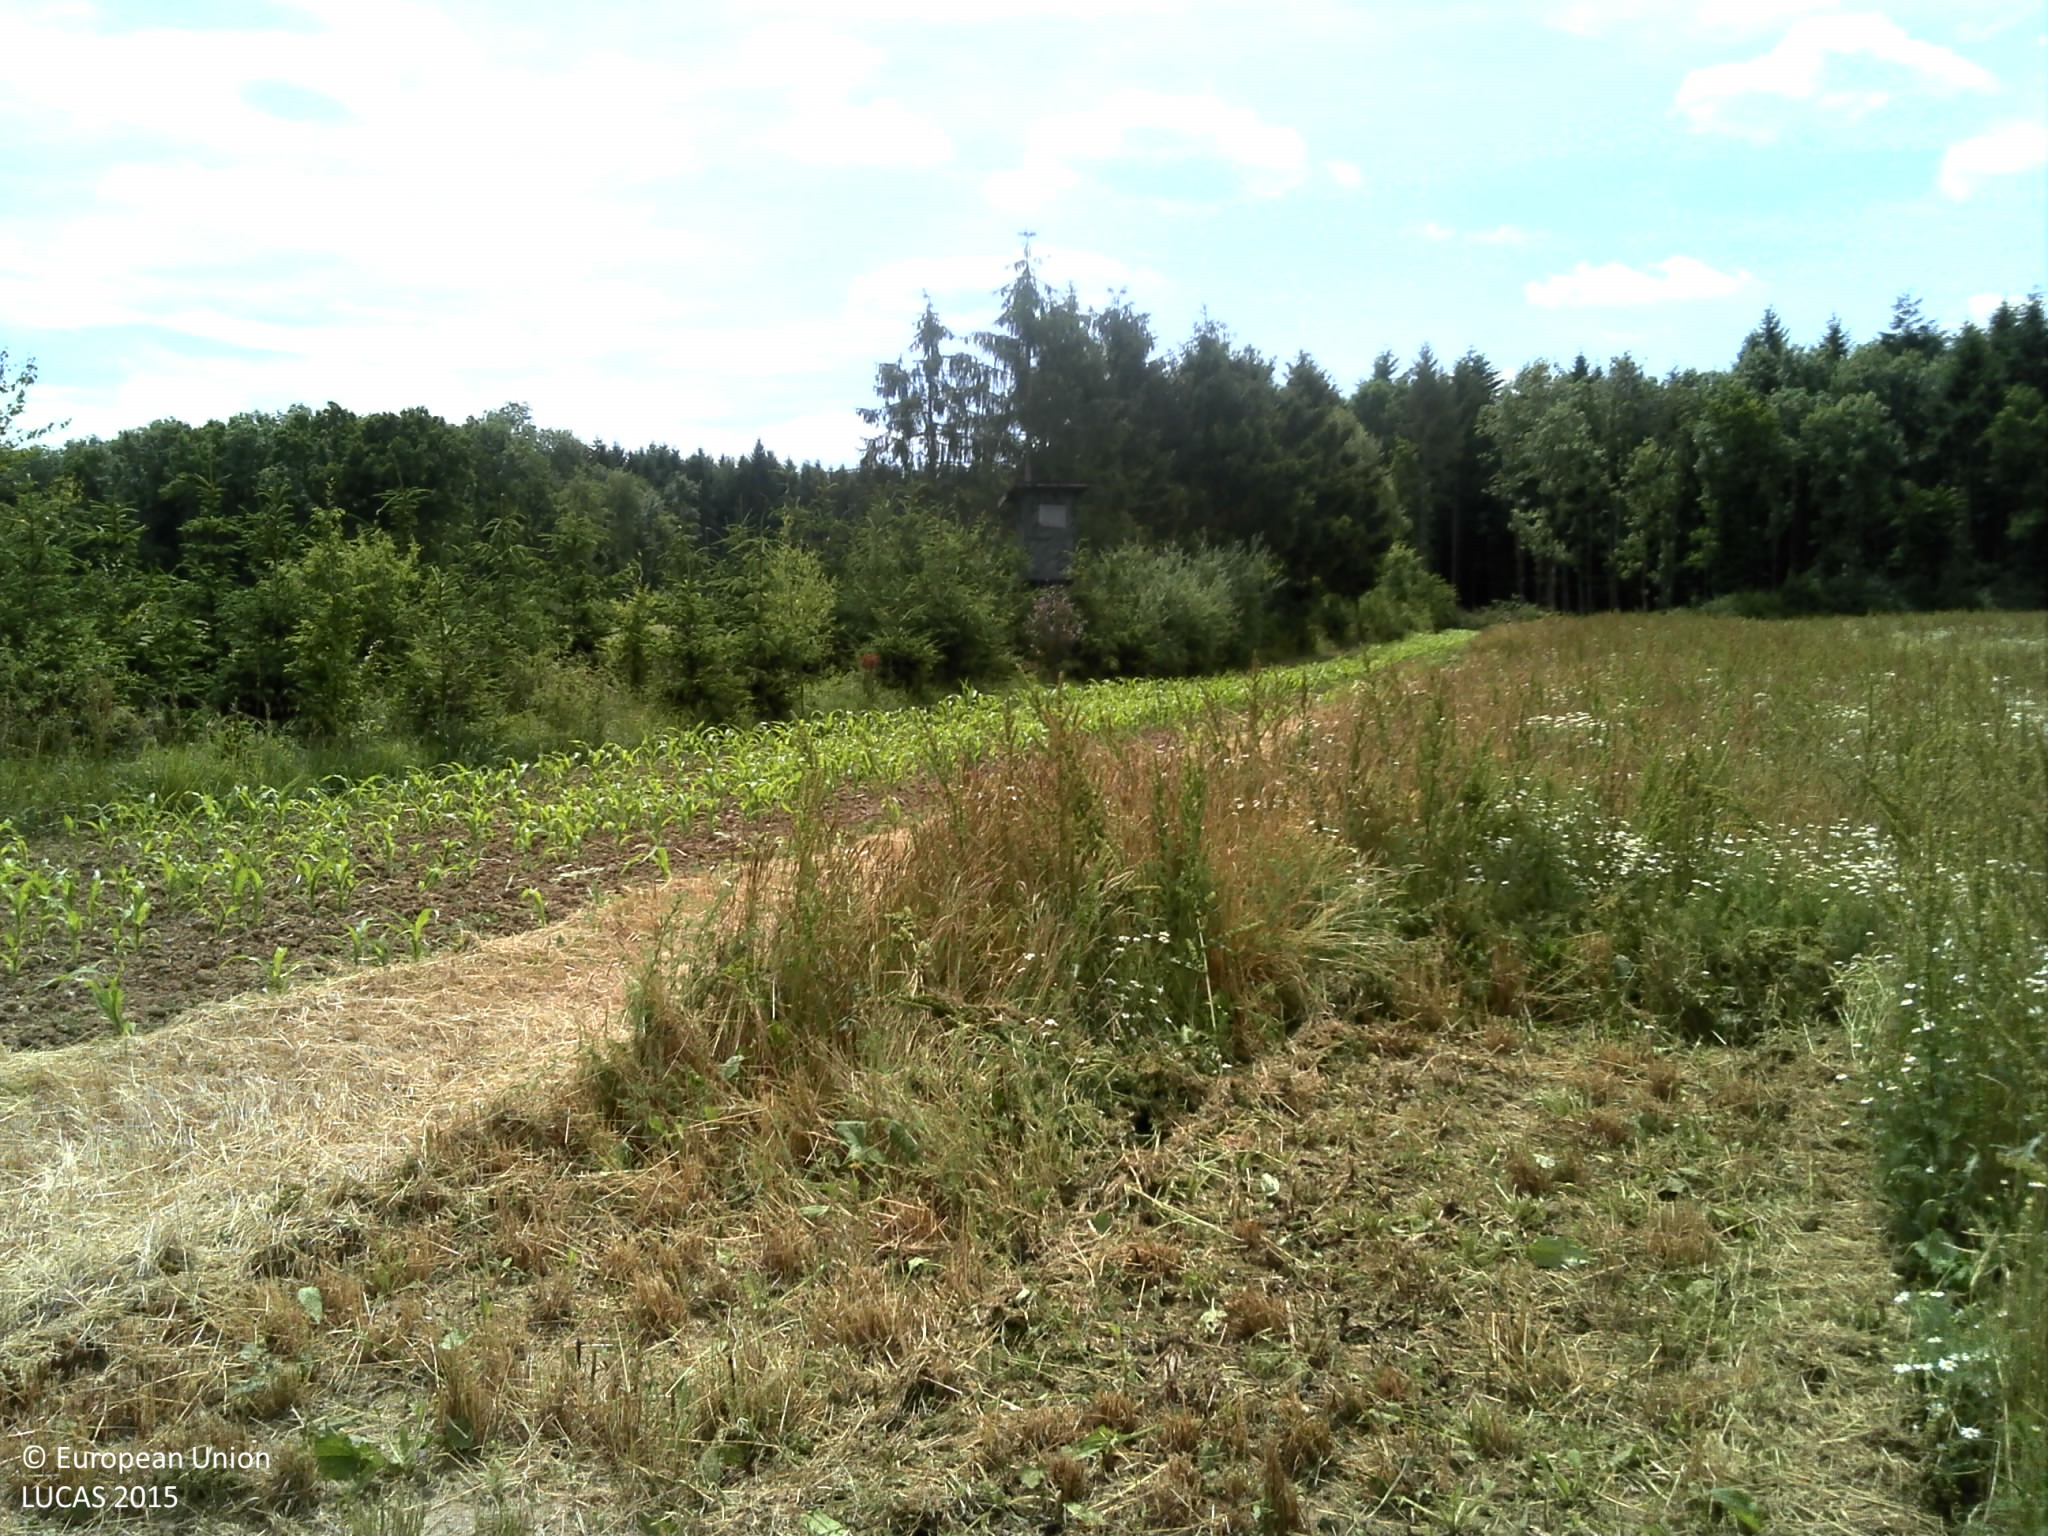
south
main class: Grassland
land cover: Grassland without tree/shrub cover
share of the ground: > 75 %
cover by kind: herbaceous plants 100 %
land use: Agriculture (excluding fallow land and kitchen gardens)
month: June
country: FR
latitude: 49.2943
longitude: 6.2459
